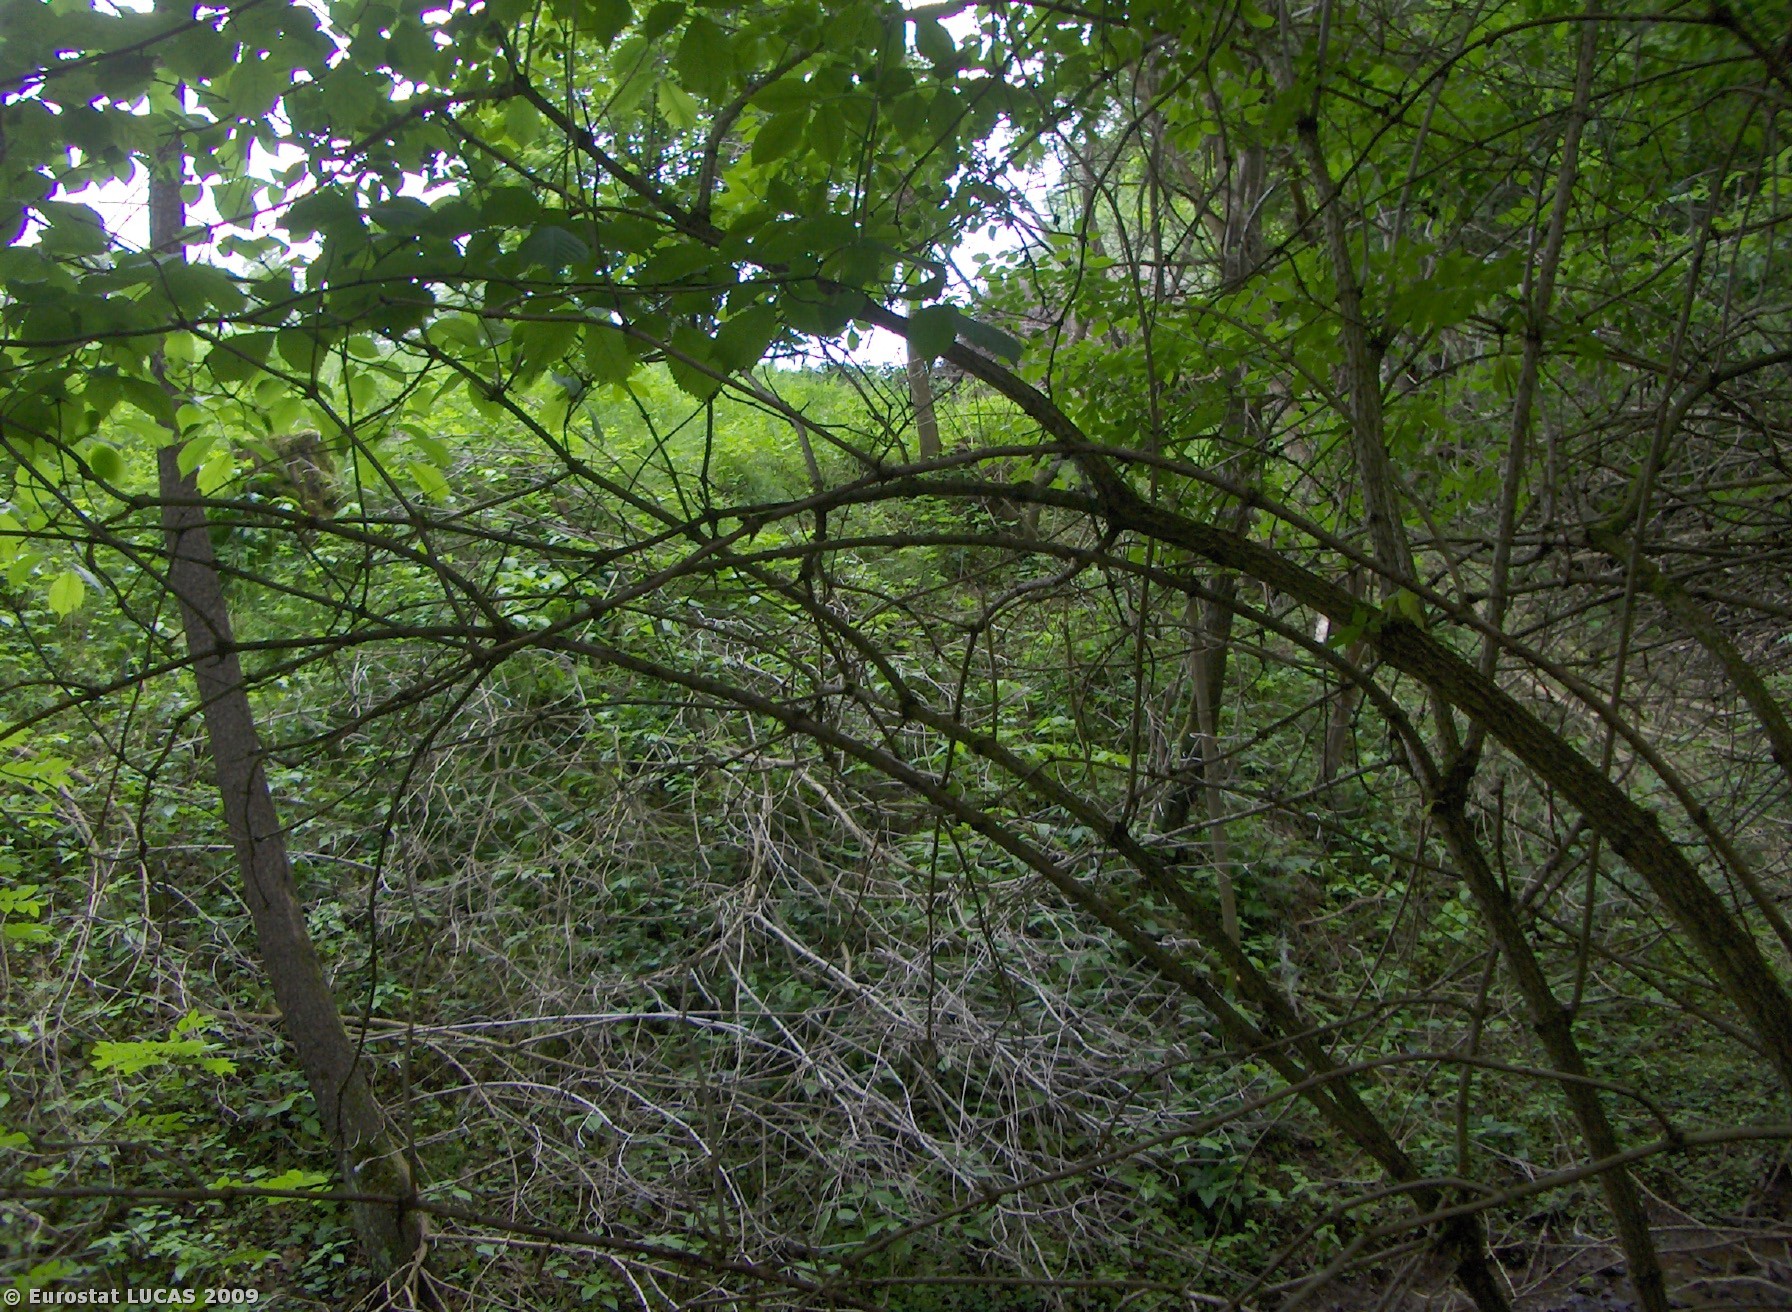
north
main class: Woodland
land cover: Broadleaved woodland
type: mesophytic deciduous forest
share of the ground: > 75 %
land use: Forestry
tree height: > 5 m
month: May
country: CZ
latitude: 49.6146
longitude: 14.3610
